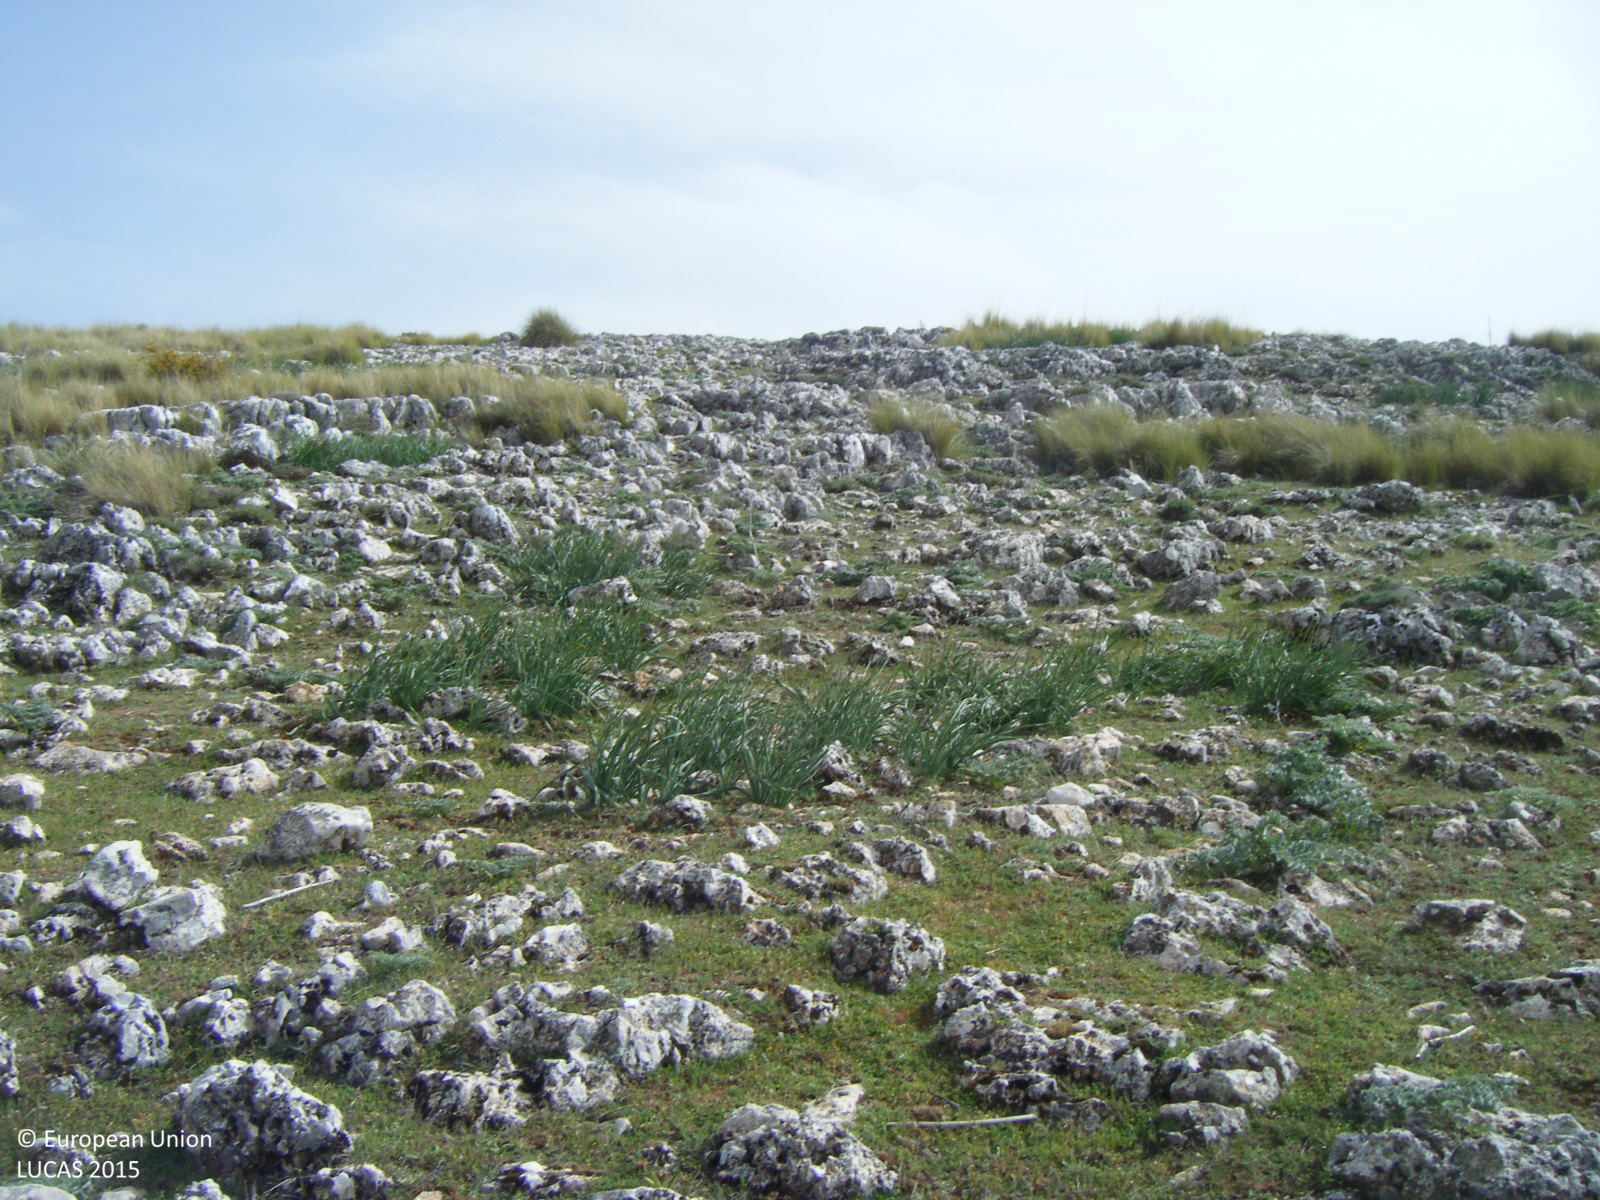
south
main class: Grassland
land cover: Grassland without tree/shrub cover
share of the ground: > 75 %
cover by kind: herbaceous plants 75 %, consolidated bare surface 25 %
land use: Agriculture (excluding fallow land and kitchen gardens)
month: April
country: ES
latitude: 37.0580
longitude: -4.1055
